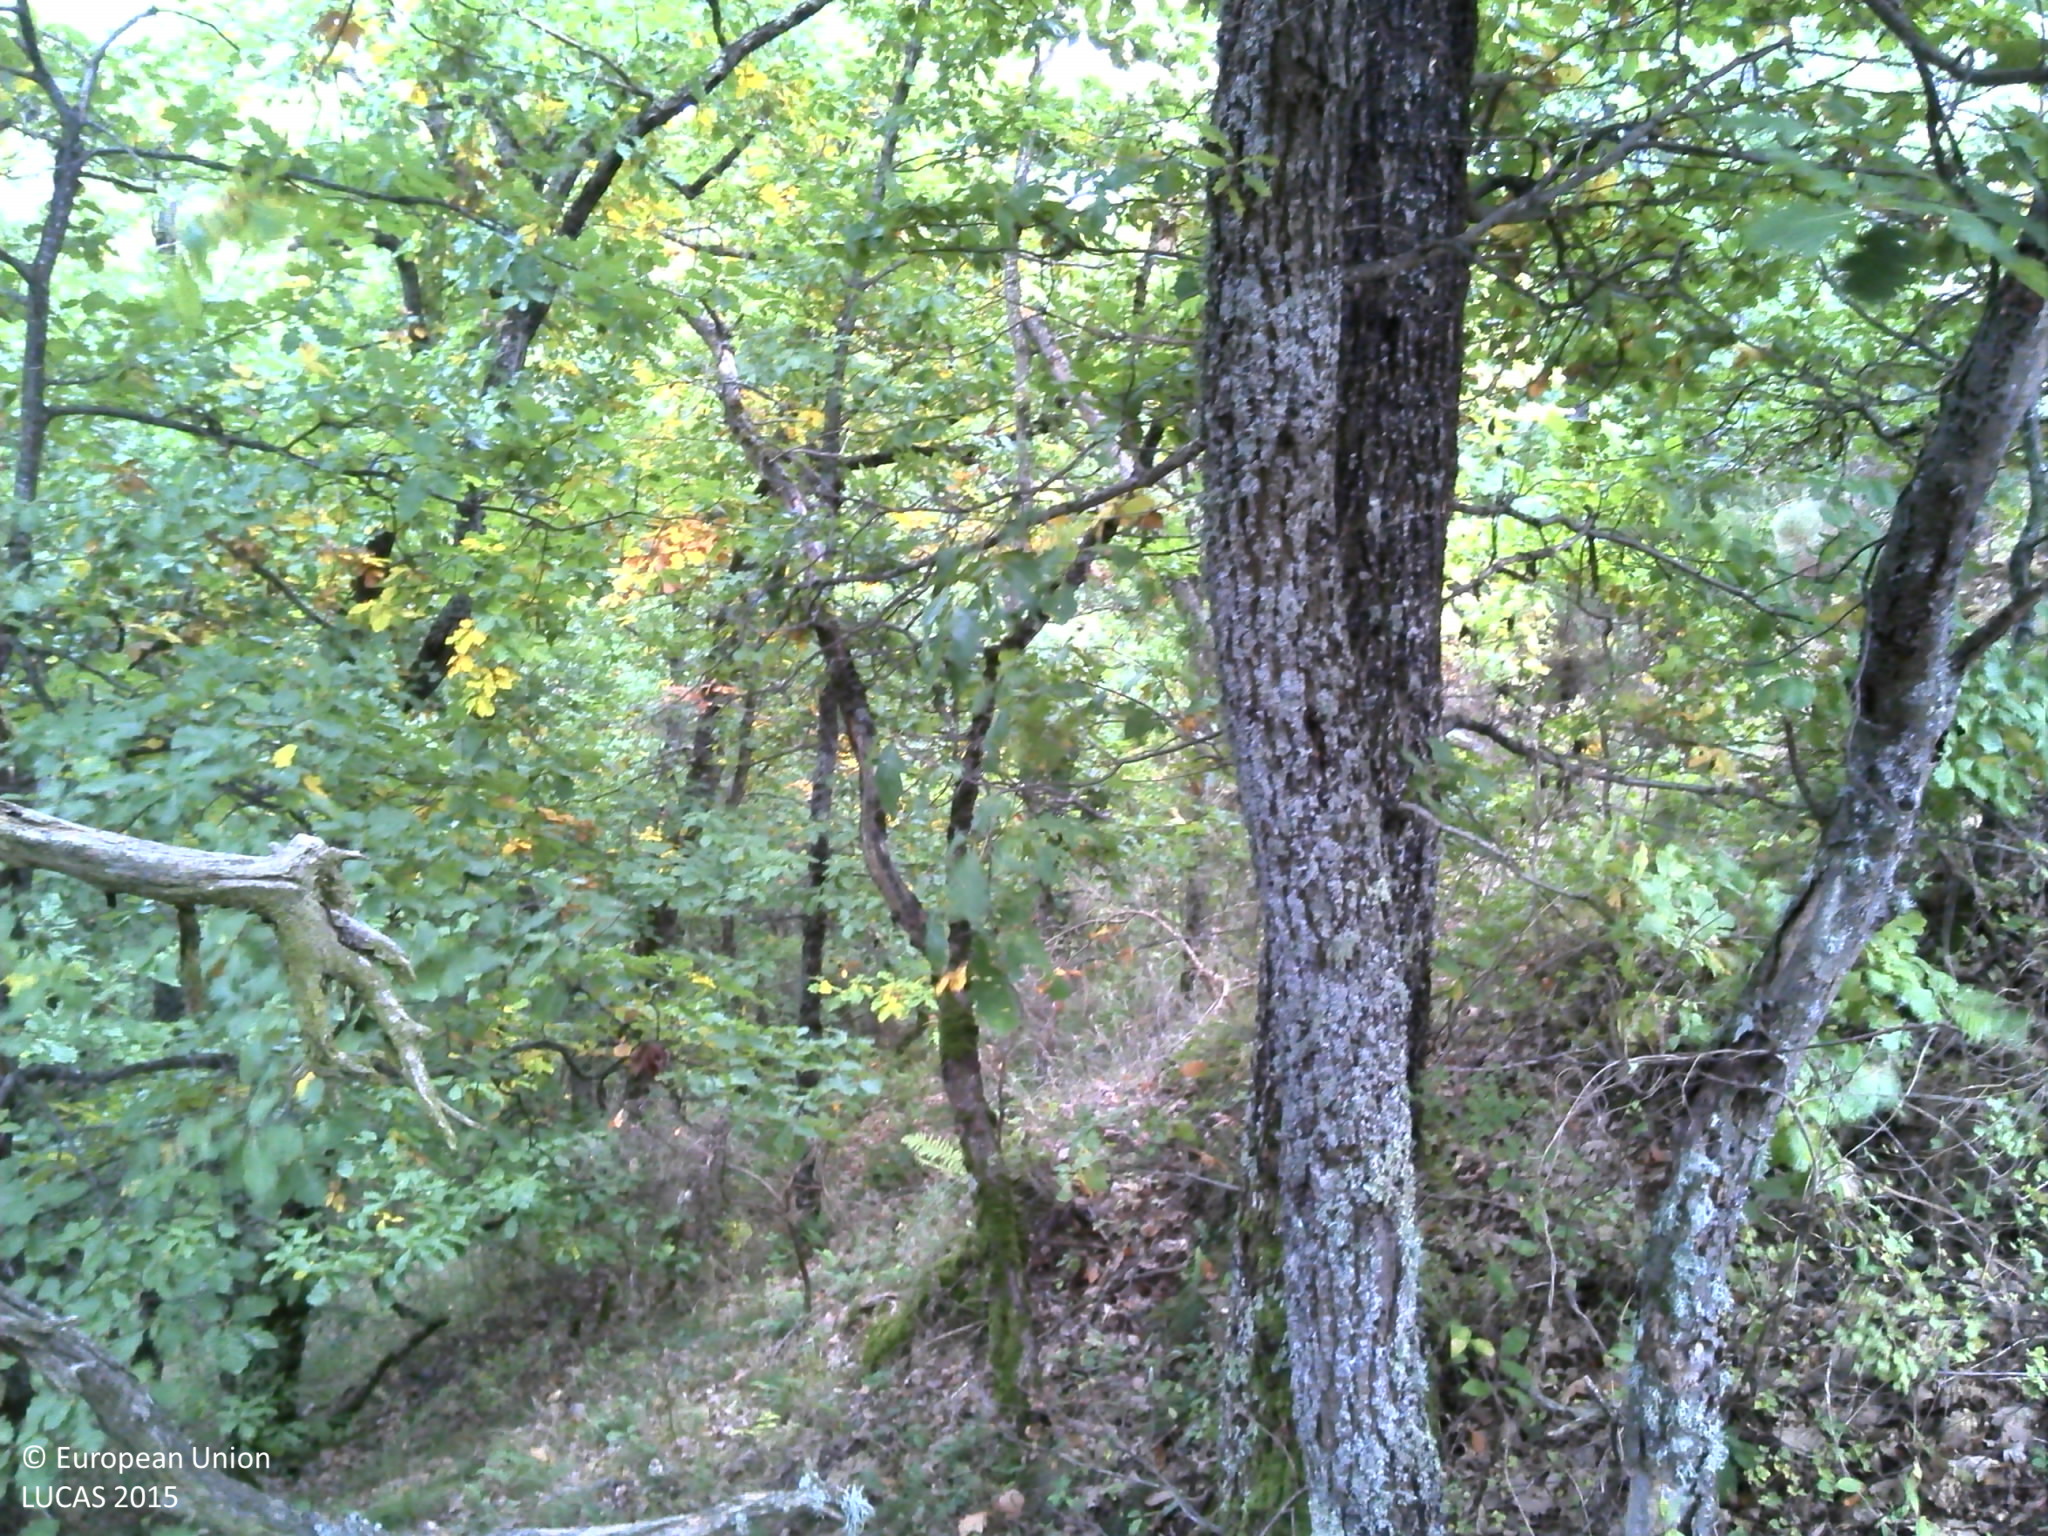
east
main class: Woodland
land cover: Pine dominated mixed woodland
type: alpine coniferous forest
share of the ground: > 75 %
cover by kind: coniferous forest trees 50 %, broadleaved forest trees 25 %, herbaceous plants 15 %, unconsolidated bare surface 10 %
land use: Forestry
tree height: > 5 m
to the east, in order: Pine dominated mixed woodland; Broadleaved woodland; Artificial constructions in urban areas
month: October
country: FR
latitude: 45.4061
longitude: 3.1145
